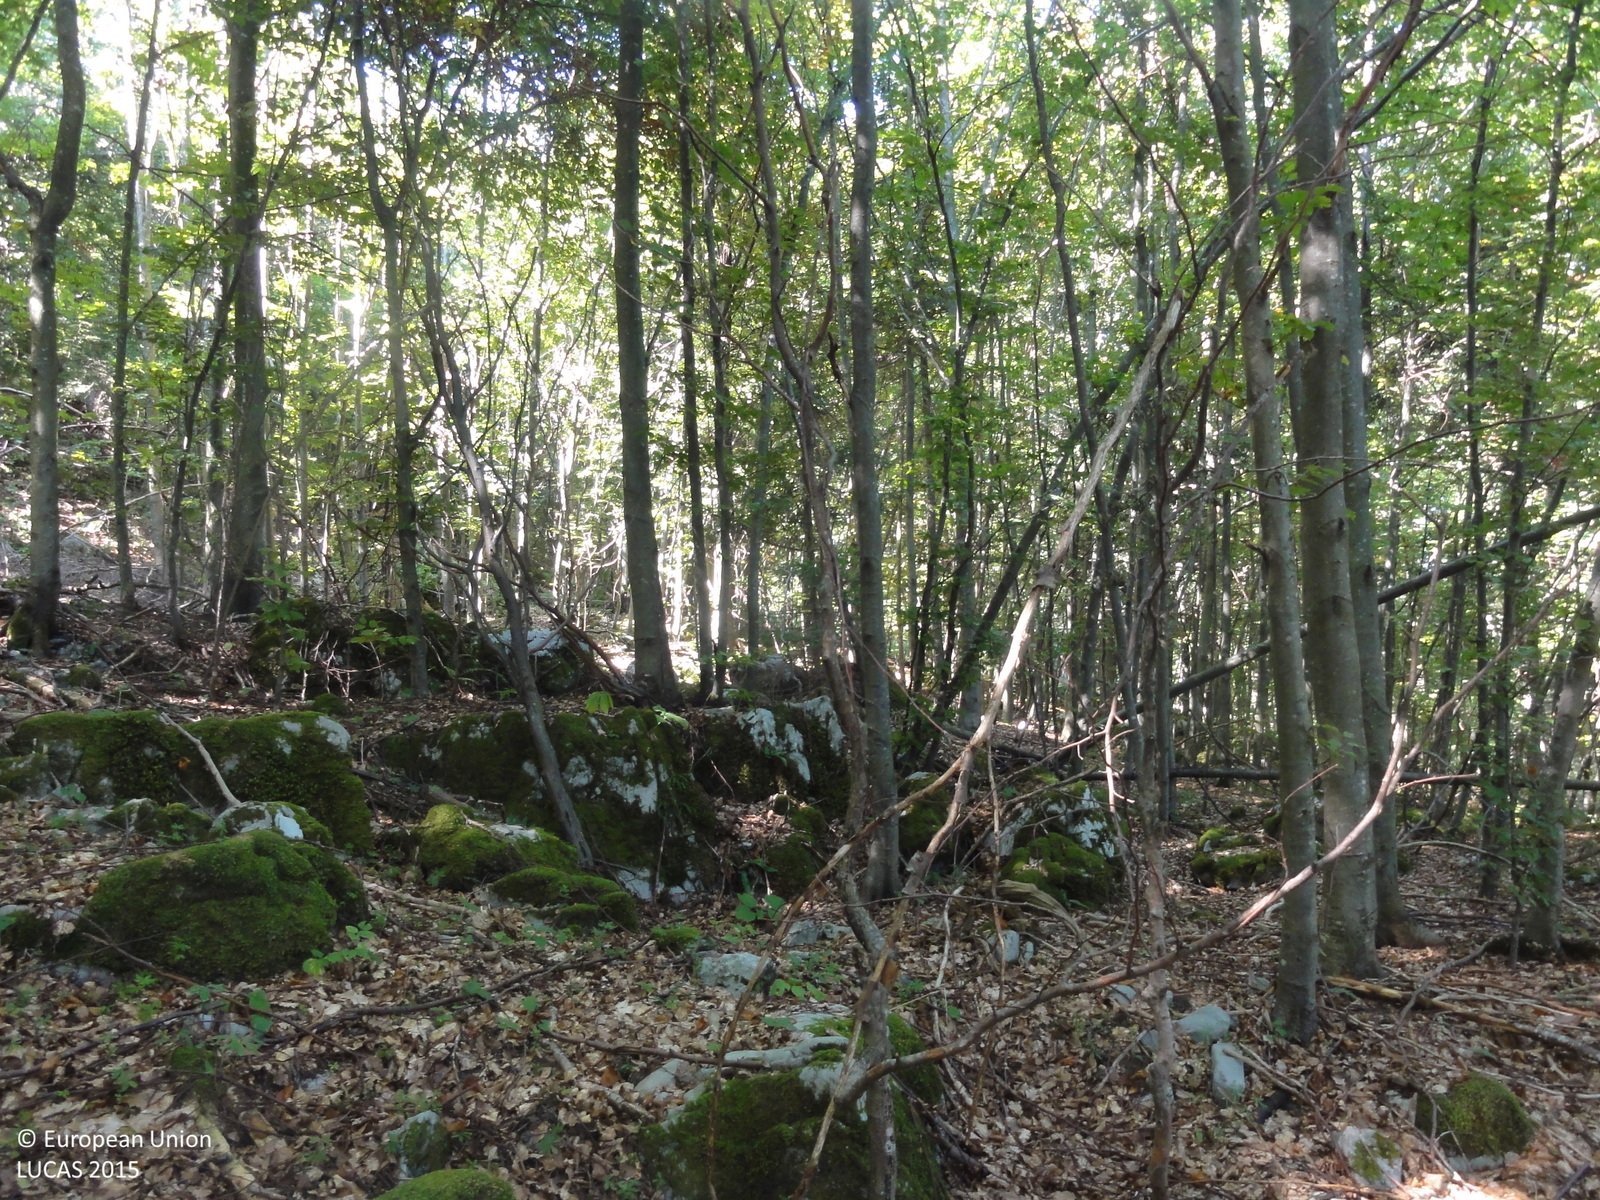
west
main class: Woodland
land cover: Broadleaved woodland
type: beech forest
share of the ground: > 75 %
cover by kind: broadleaved forest trees 90 %, coniferous forest trees 5 %, unconsolidated bare surface 5 %
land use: Forestry
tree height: > 5 m
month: September
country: SI
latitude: 45.7652
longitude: 14.9981
